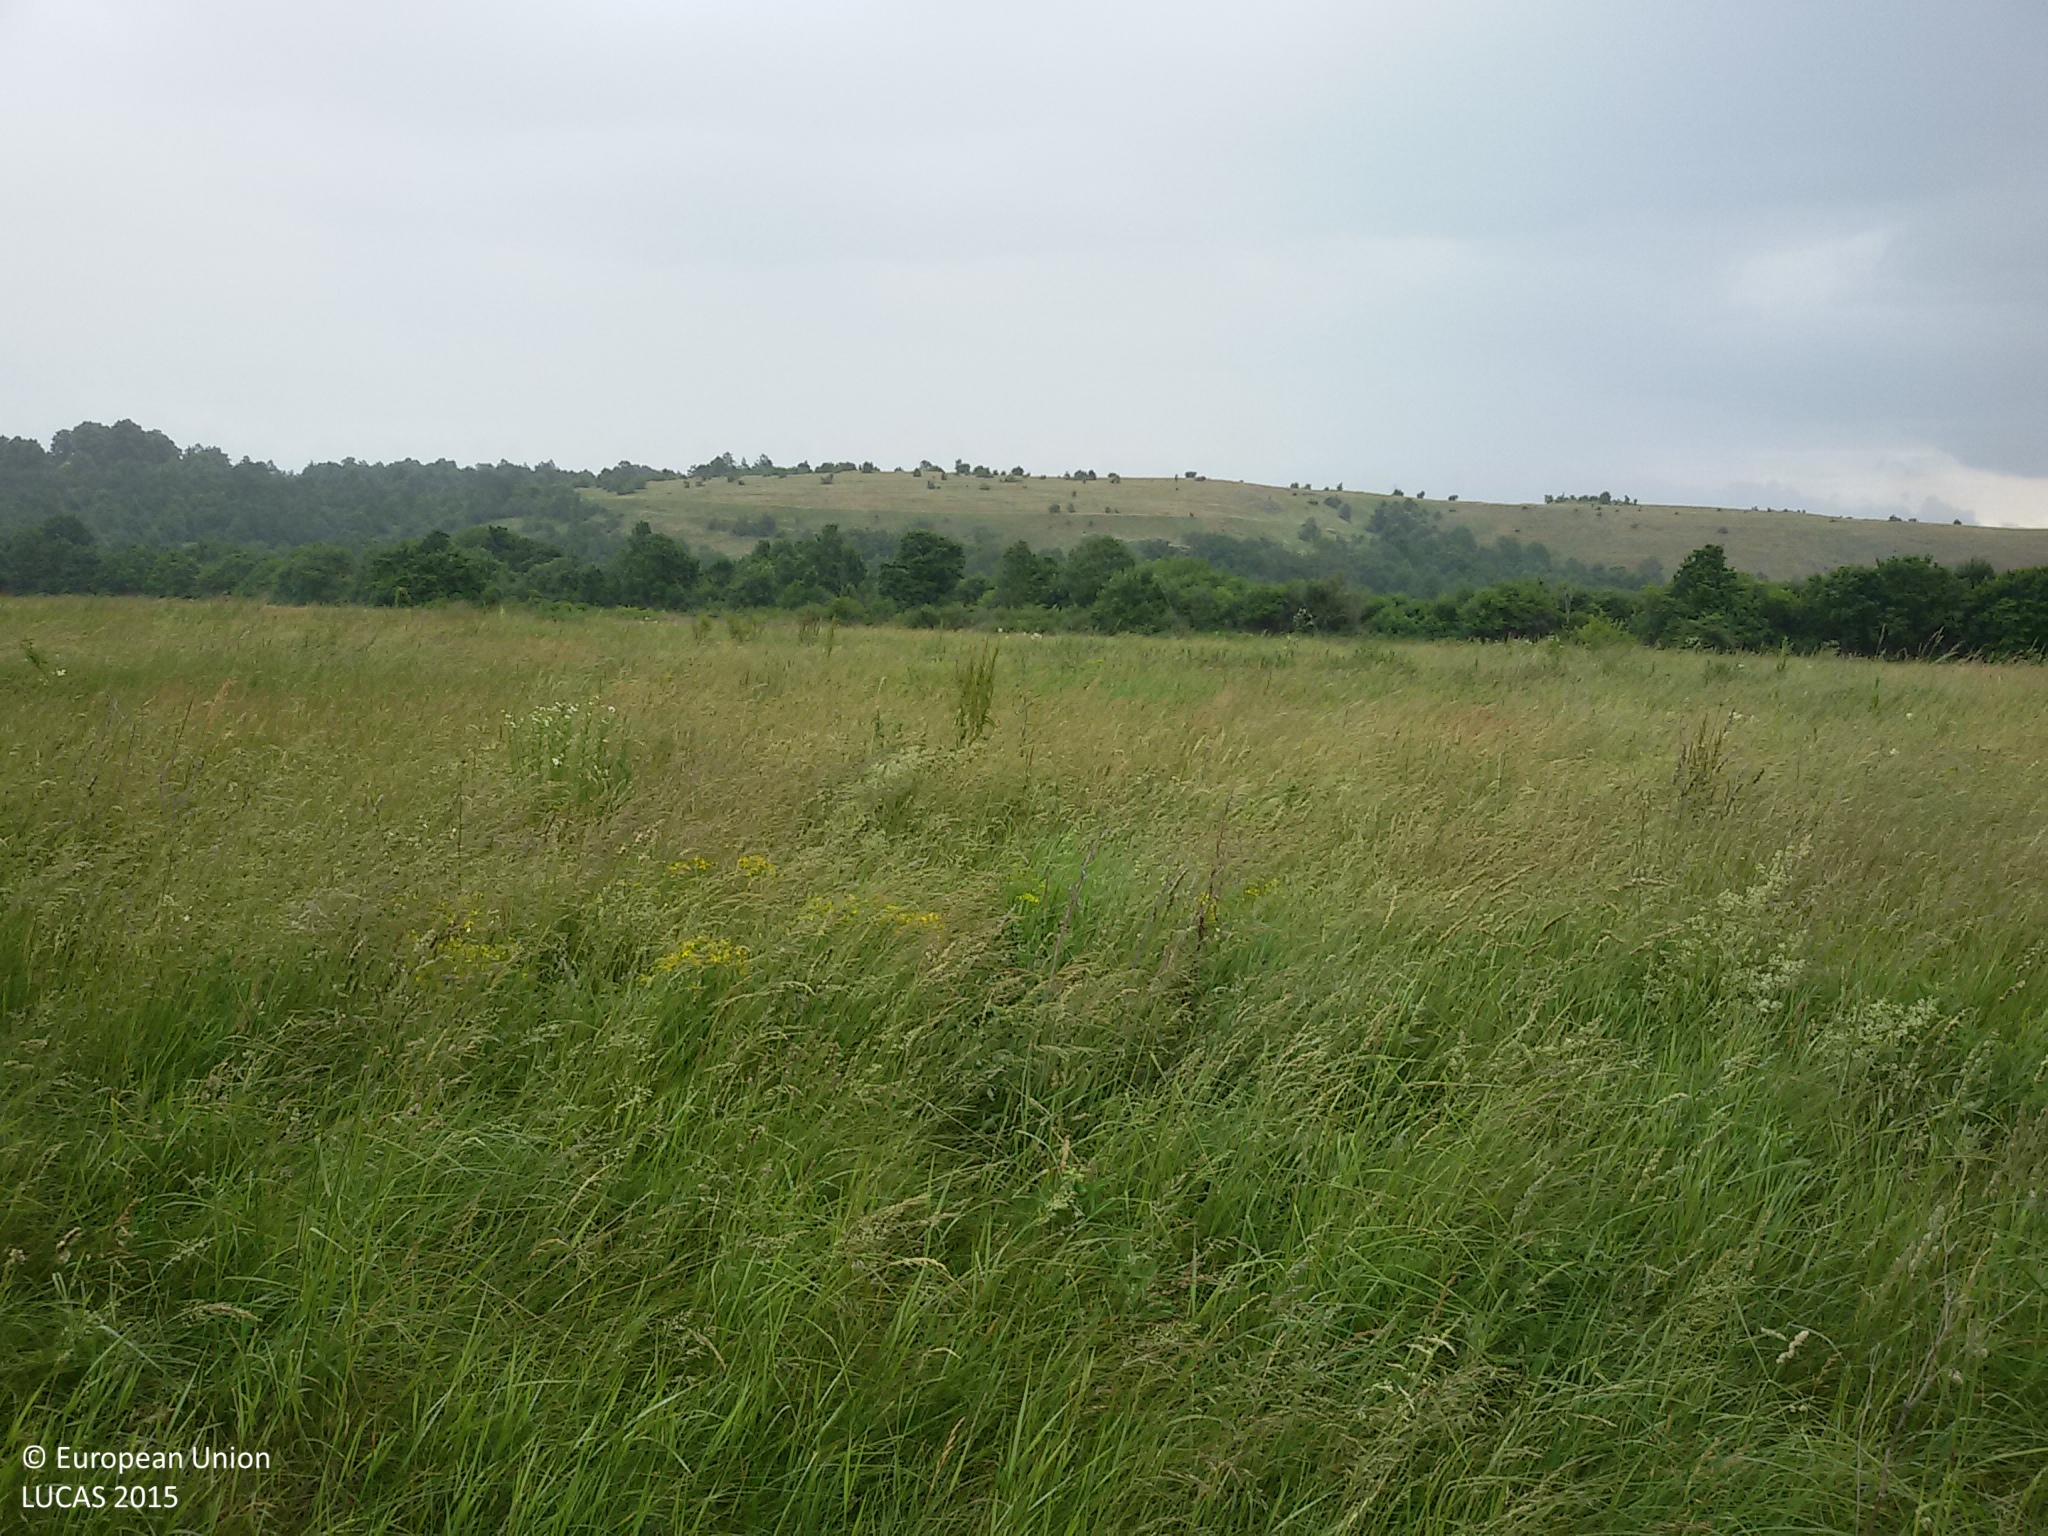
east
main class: Grassland
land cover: Grassland without tree/shrub cover
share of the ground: > 75 %
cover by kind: herbaceous plants 95 %, unconsolidated bare surface 5 %
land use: Agriculture (excluding fallow land and kitchen gardens)
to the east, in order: Grassland without tree/shrub cover; Shrubland with sparse tree cover; Grassland without tree/shrub cover; Broadleaved woodland; Tracks; Grass margins; Broadleaved woodland; Dry stone walls; Broadleaved woodland; Shrubland with sparse tree cover; Broadleaved woodland
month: June
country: HR
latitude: 44.6136
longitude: 15.6266
